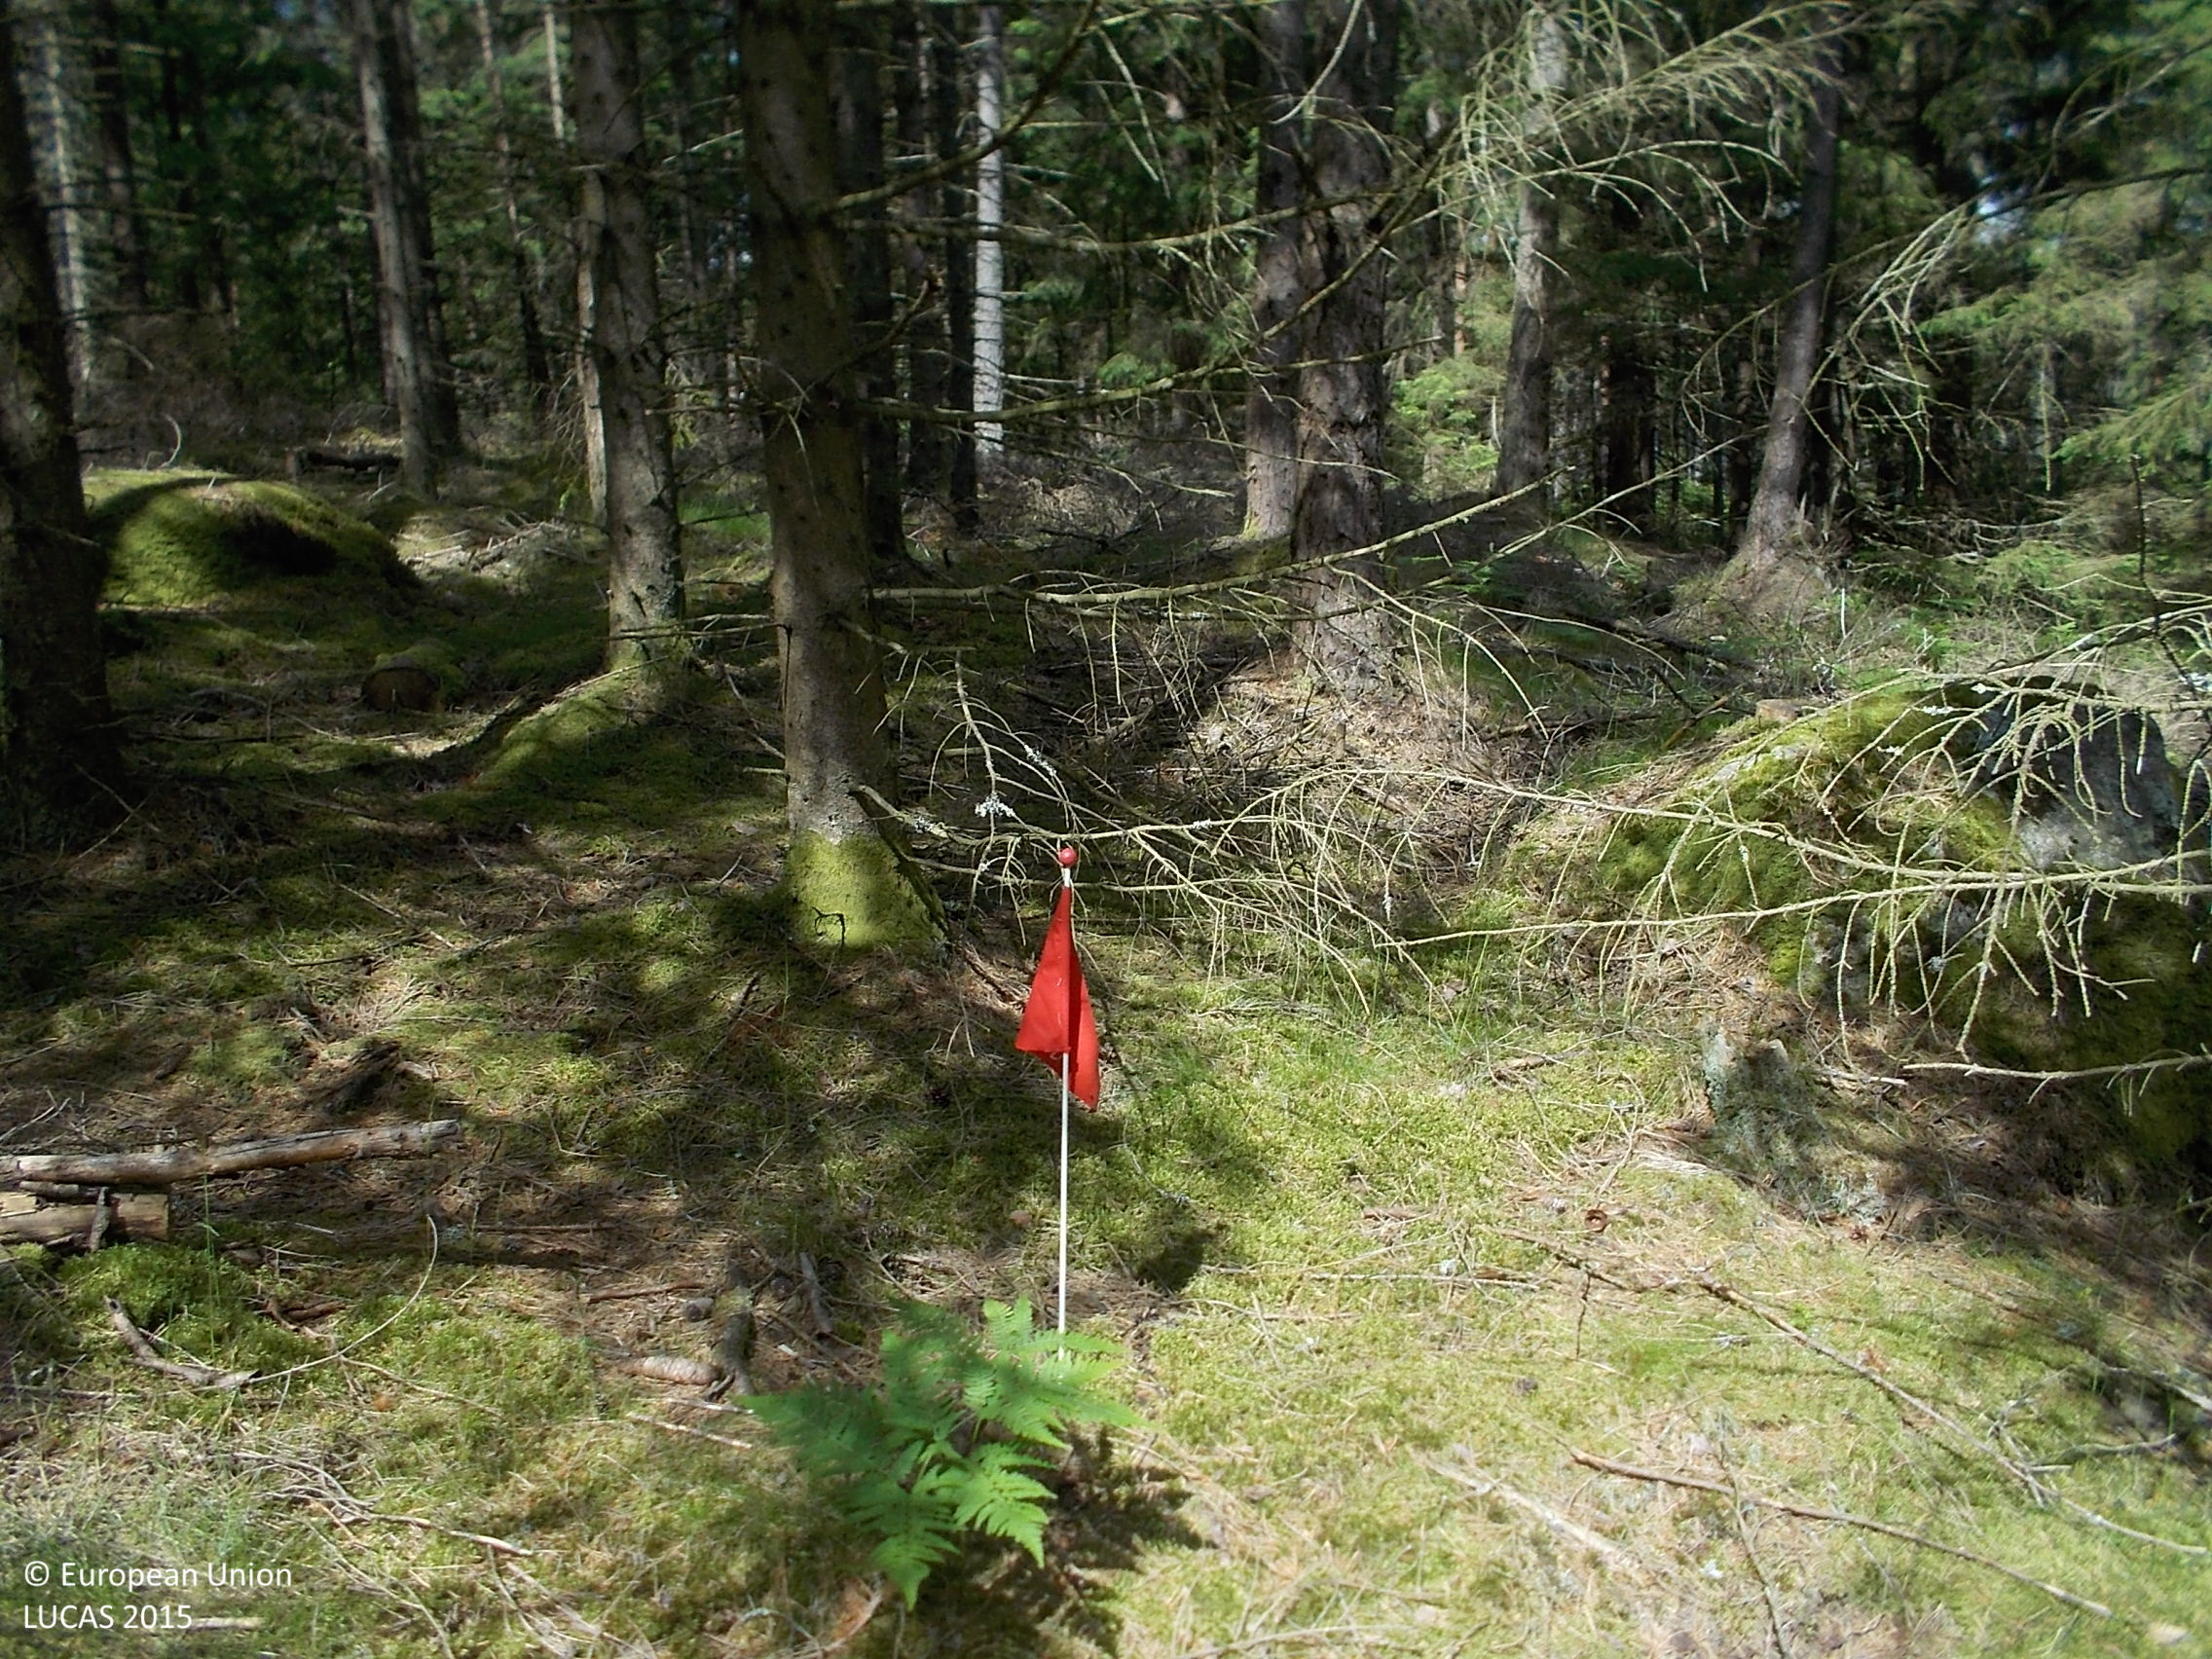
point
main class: Woodland
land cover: Spruce dominated coniferous woodland
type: boreal forest
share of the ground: > 75 %
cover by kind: coniferous forest trees 90 %, herbaceous plants 5 %, lichens and mosses 5 %
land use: Forestry
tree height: > 5 m
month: June
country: SE
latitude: 57.3206
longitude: 13.0681
